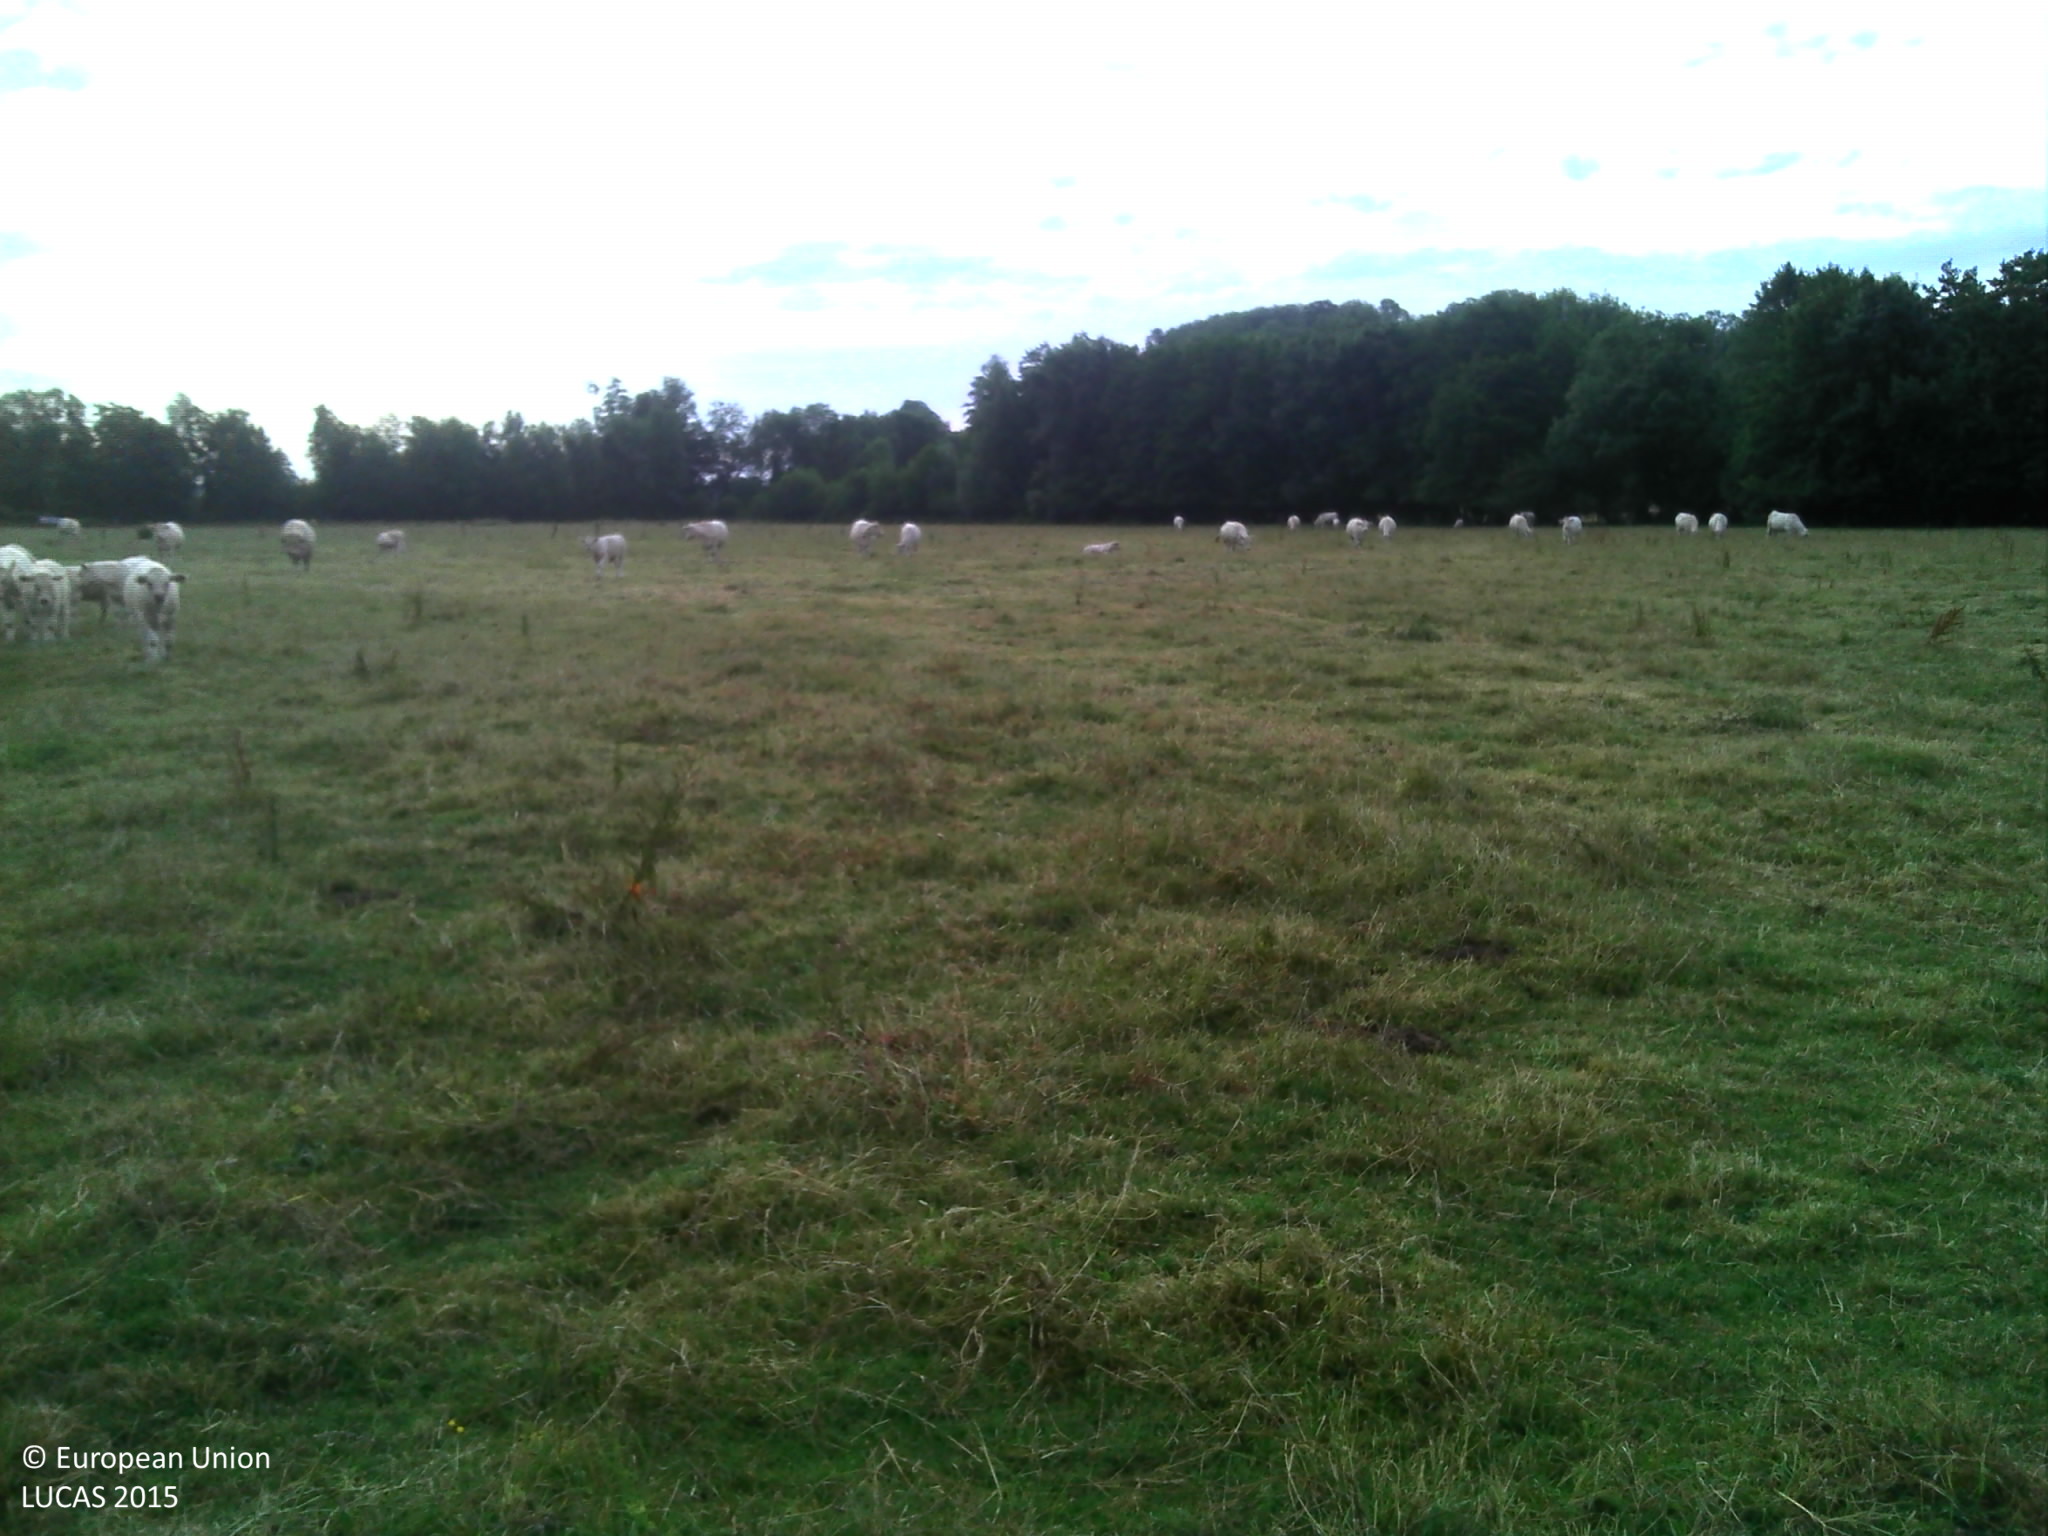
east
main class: Grassland
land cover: Grassland without tree/shrub cover
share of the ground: > 75 %
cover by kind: herbaceous plants 100 %
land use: Agriculture (excluding fallow land and kitchen gardens)
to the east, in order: Grassland without tree/shrub cover
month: June
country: FR
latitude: 48.8491
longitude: 4.9967
